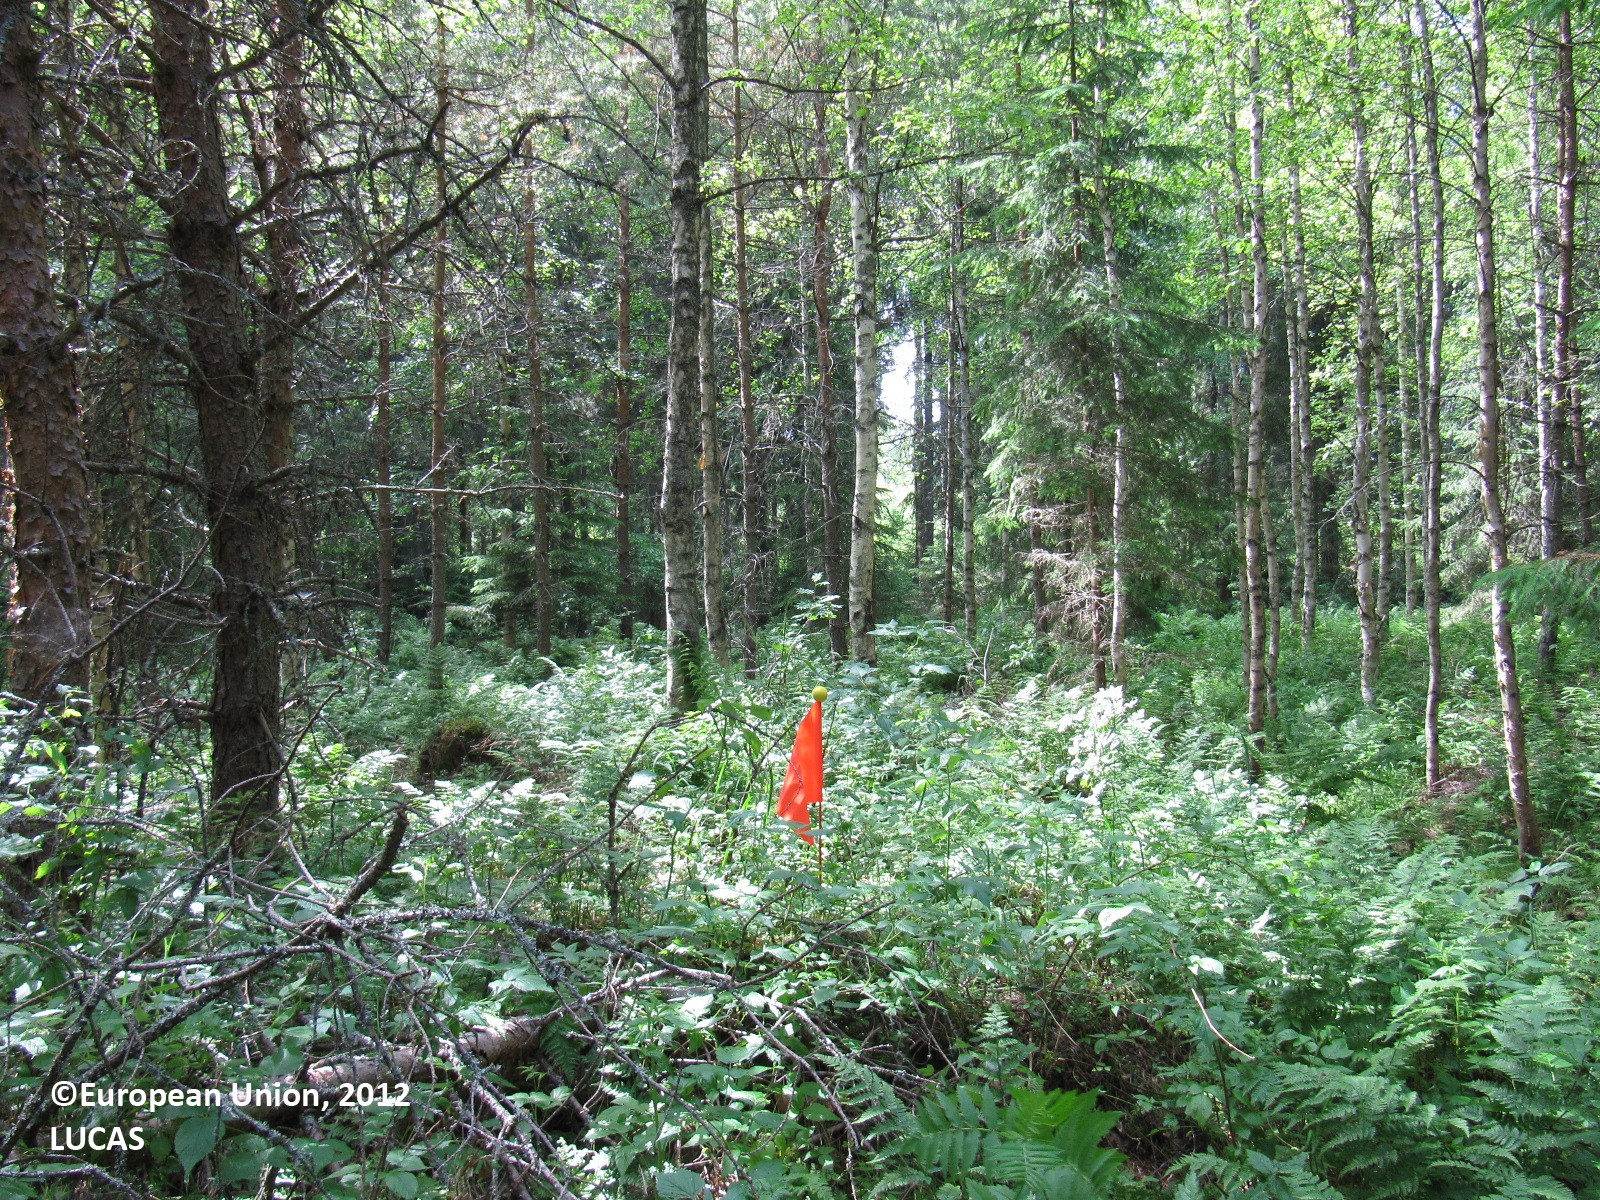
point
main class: Woodland
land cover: Spruce dominated mixed woodland
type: boreal forest
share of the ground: > 75 %
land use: Forestry
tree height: > 5 m
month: July
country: FI
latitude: 60.8806
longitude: 23.3262
